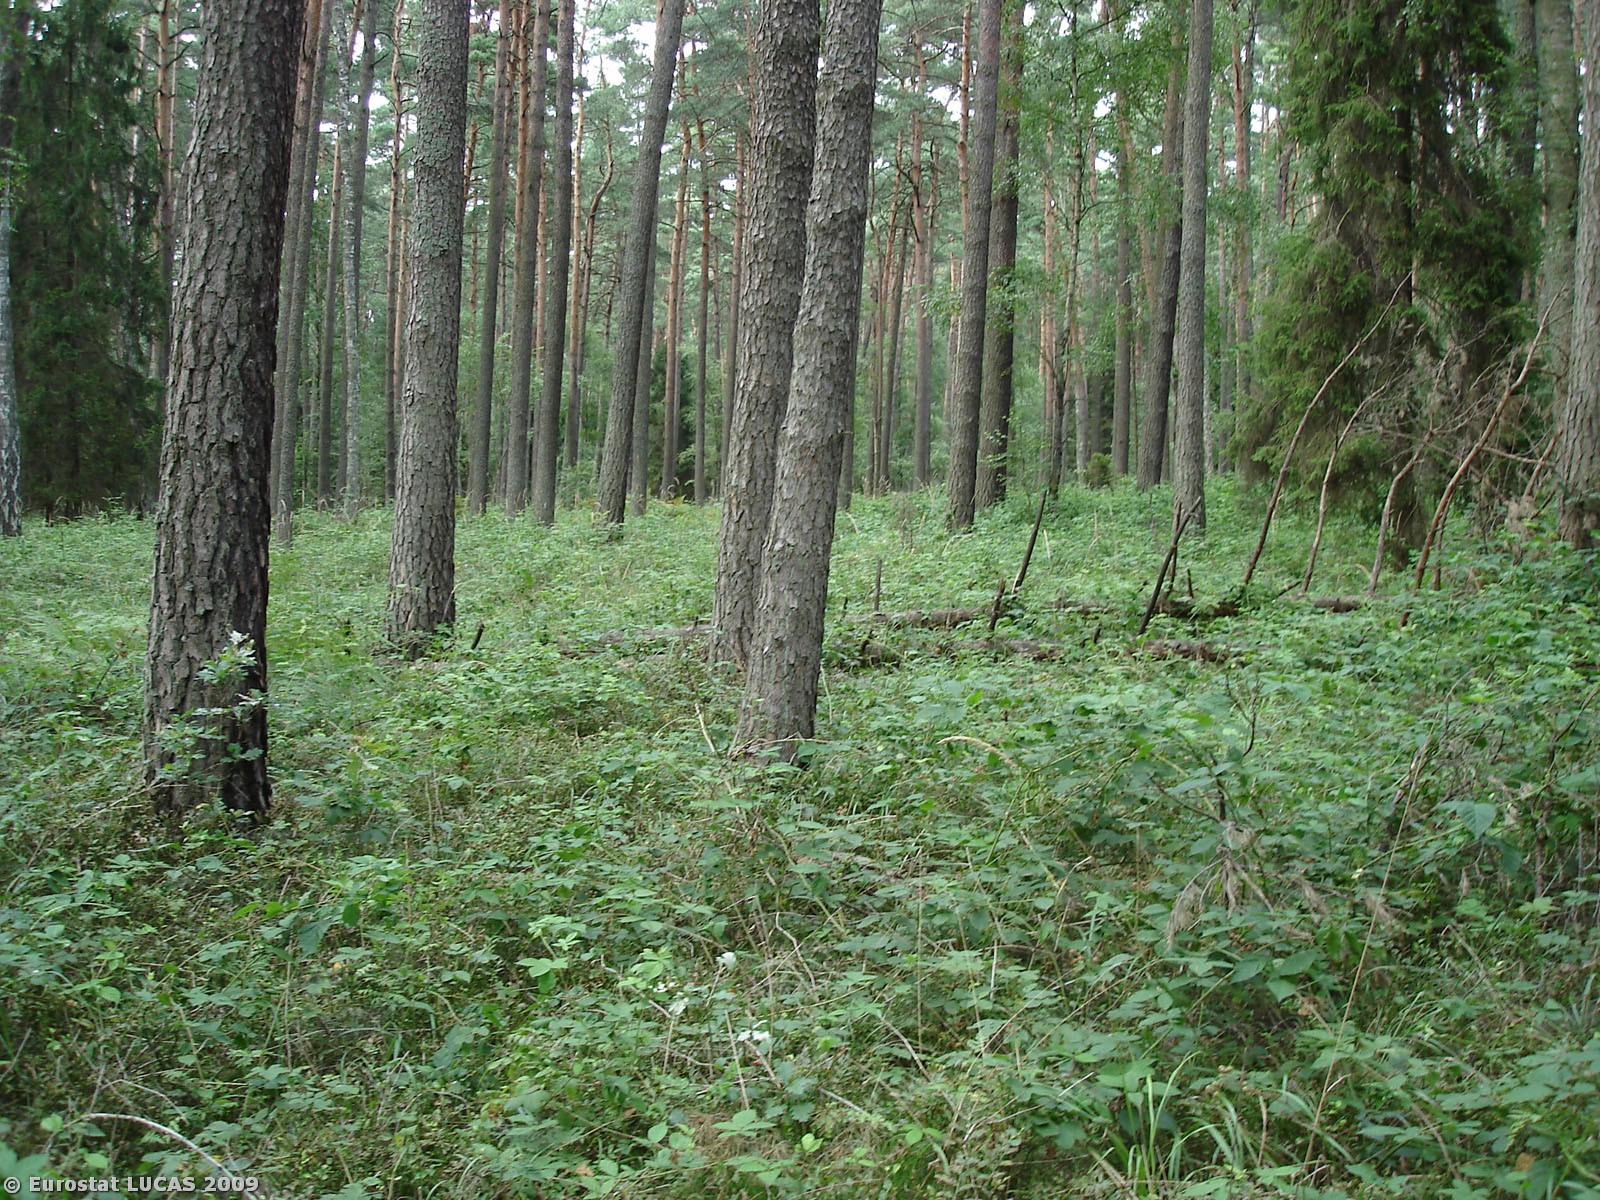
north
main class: Woodland
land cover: Coniferous woodland
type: hemiboreal forest and nemoral coniferous forest and mixed broadleaved-coniferous forest
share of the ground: > 75 %
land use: Forestry
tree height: > 5 m
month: August
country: PL
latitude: 50.7881
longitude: 18.2591
